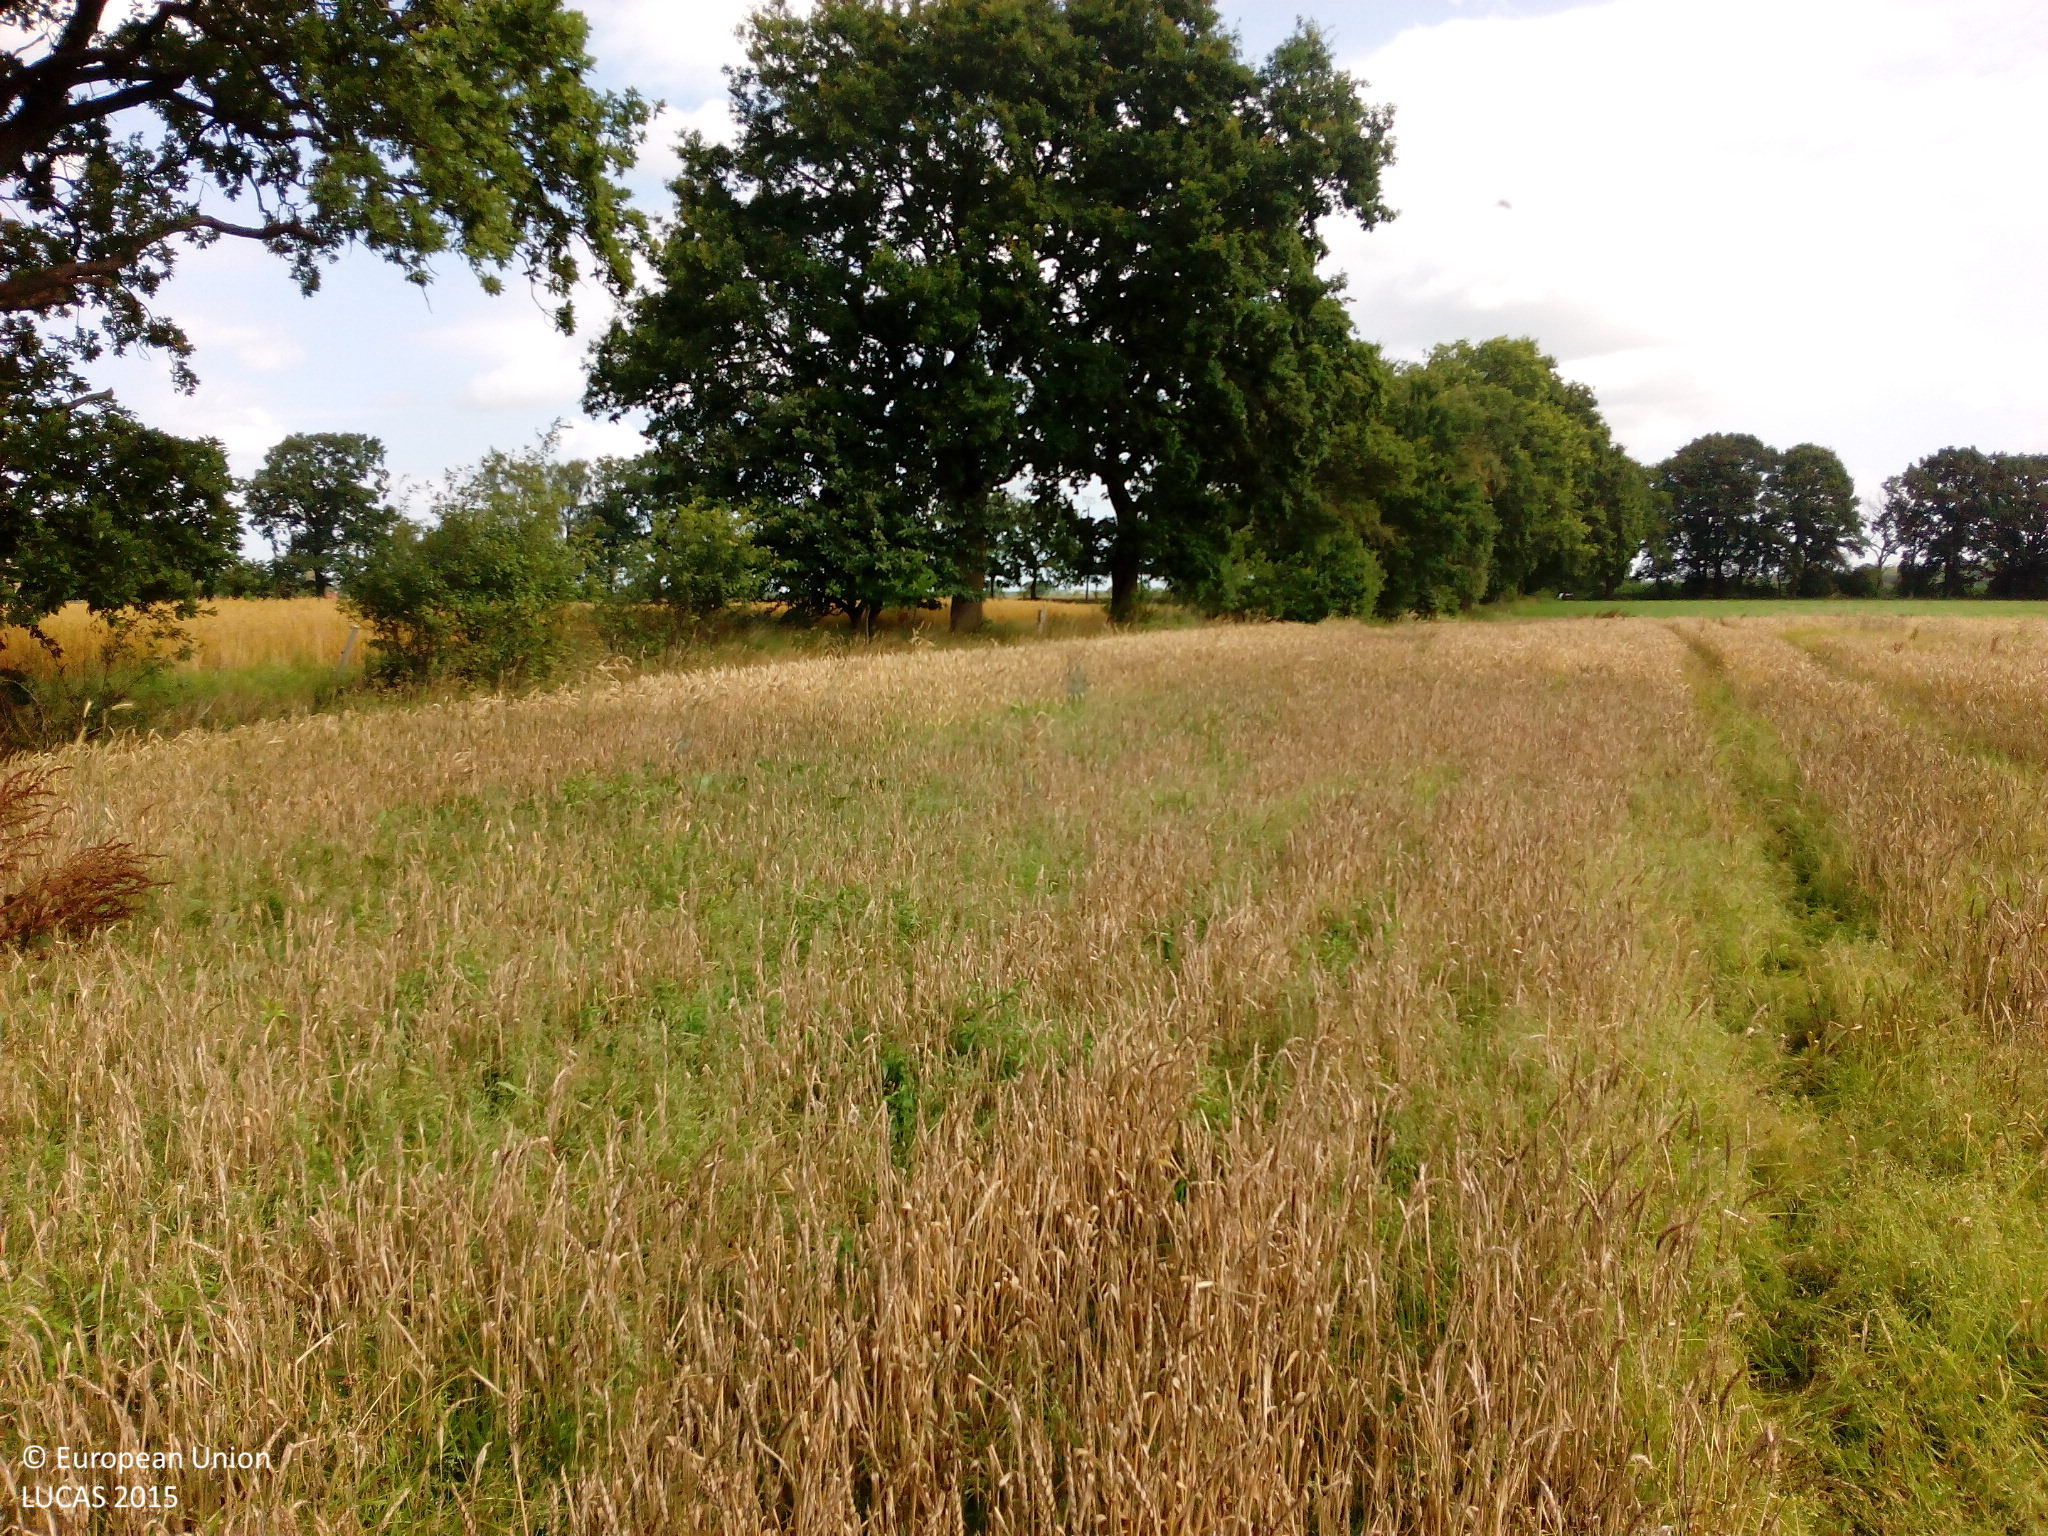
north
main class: Cropland
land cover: Common wheat
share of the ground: > 75 %
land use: Agriculture (excluding fallow land and kitchen gardens)
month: August
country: DE
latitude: 53.9762
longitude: 9.5581
